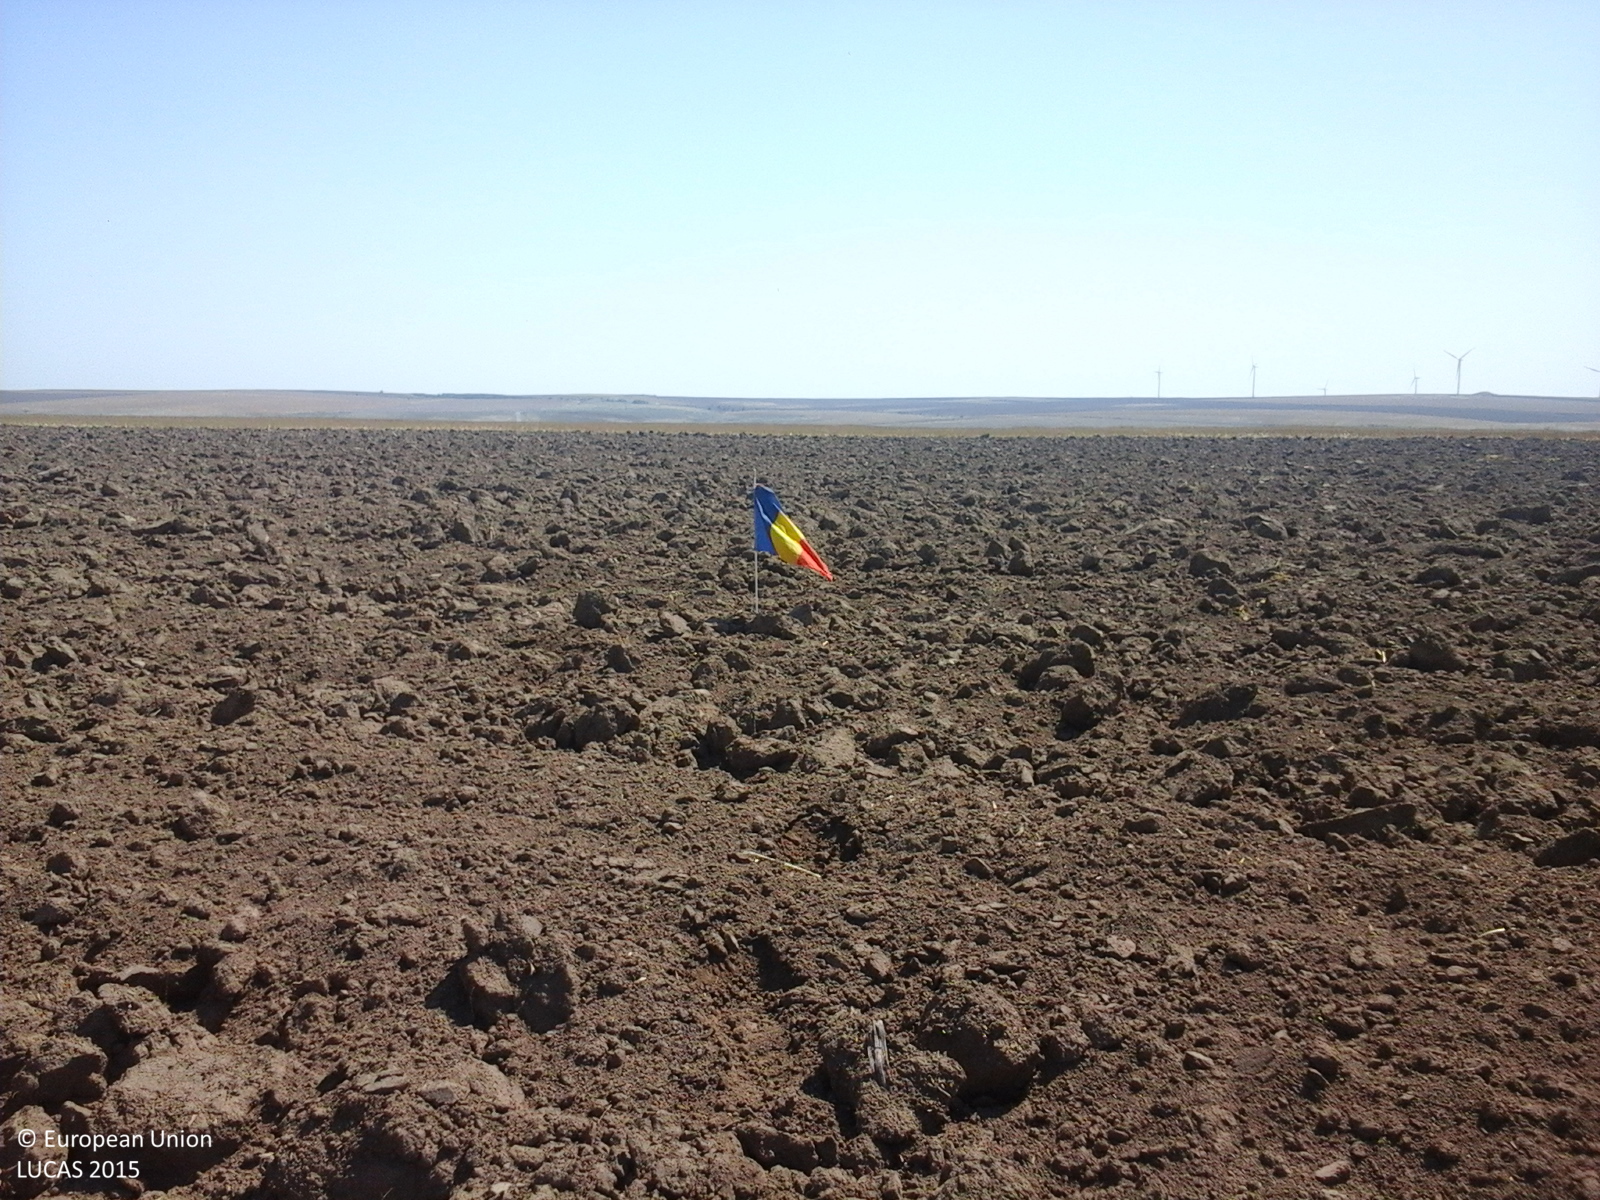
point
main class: Cropland
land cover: Durum wheat
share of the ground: < 10 %
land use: Agriculture (excluding fallow land and kitchen gardens)
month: August
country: RO
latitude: 44.4718
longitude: 28.4369
